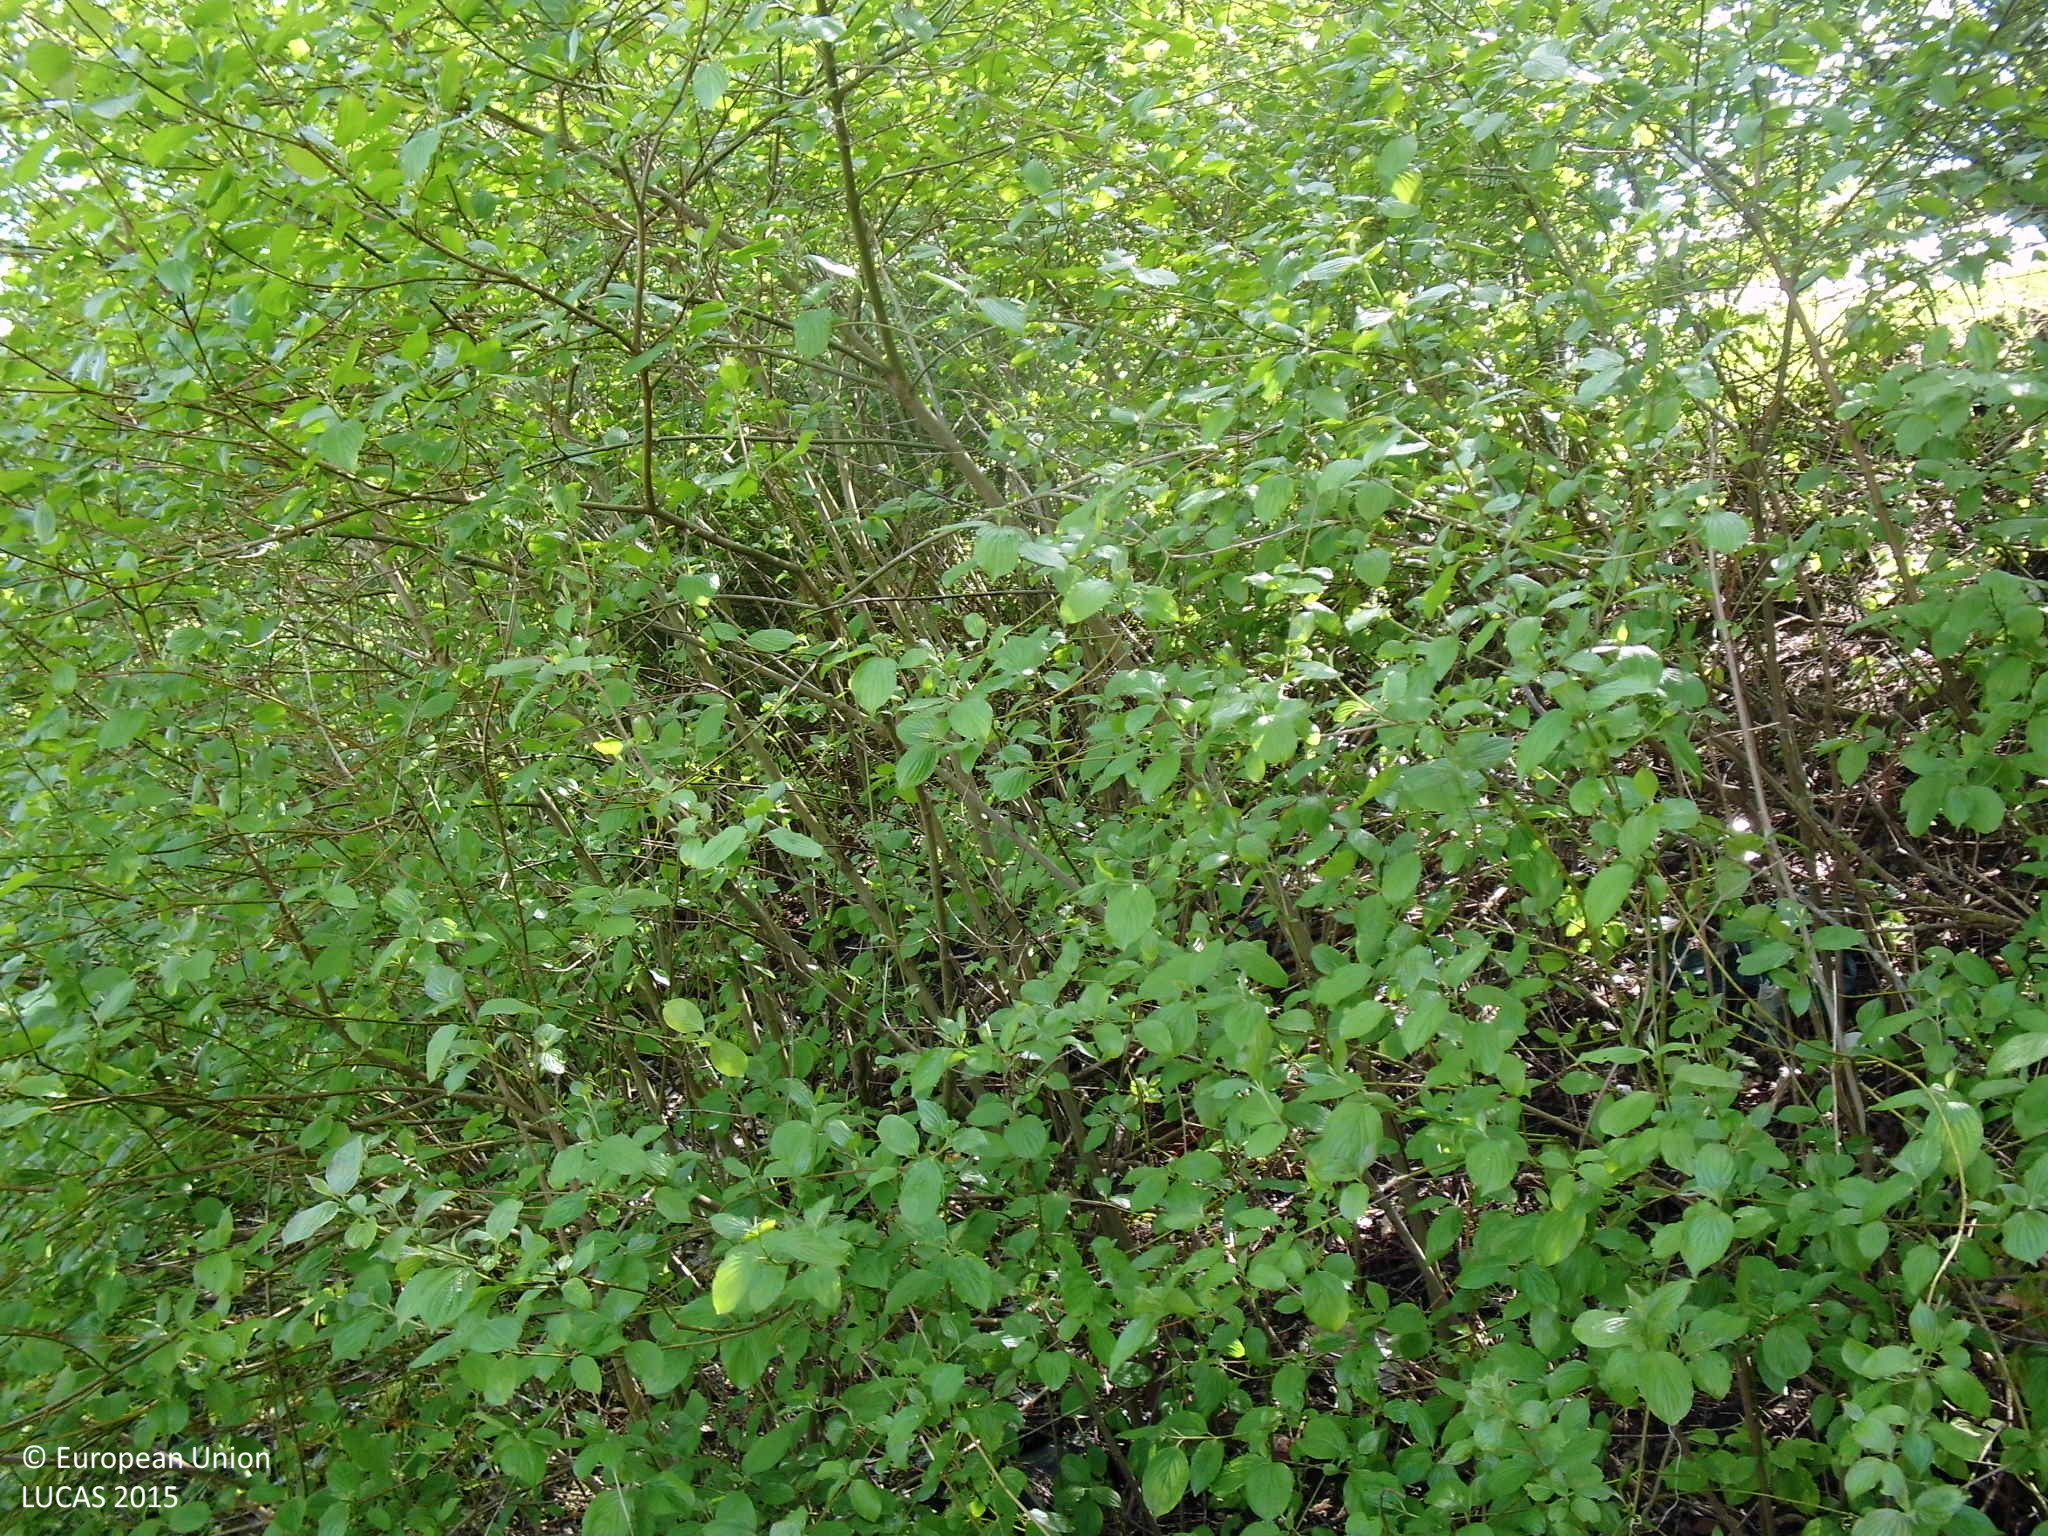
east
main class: Woodland
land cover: Broadleaved woodland
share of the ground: > 75 %
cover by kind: broadleaved forest trees 90 %, herbaceous plants 5 %, unconsolidated bare surface 5 %
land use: Road transport
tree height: > 5 m
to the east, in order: Broadleaved woodland; Grass margins; Paved roads, cycling and walking lanes; Shruby margins; Paved roads, cycling and walking lanes; Grass margins; Fences; Grassland without tree/shrub cover; Fences; Broadleaved woodland; Grassland without tree/shrub cover; Broadleaved woodland; Shrubland without tree cover; Ditches and canals; Grassland without tree/shrub cover; Tracks; Grassland without tree/shrub cover
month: May
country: DE
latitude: 51.5215
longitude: 7.3916
